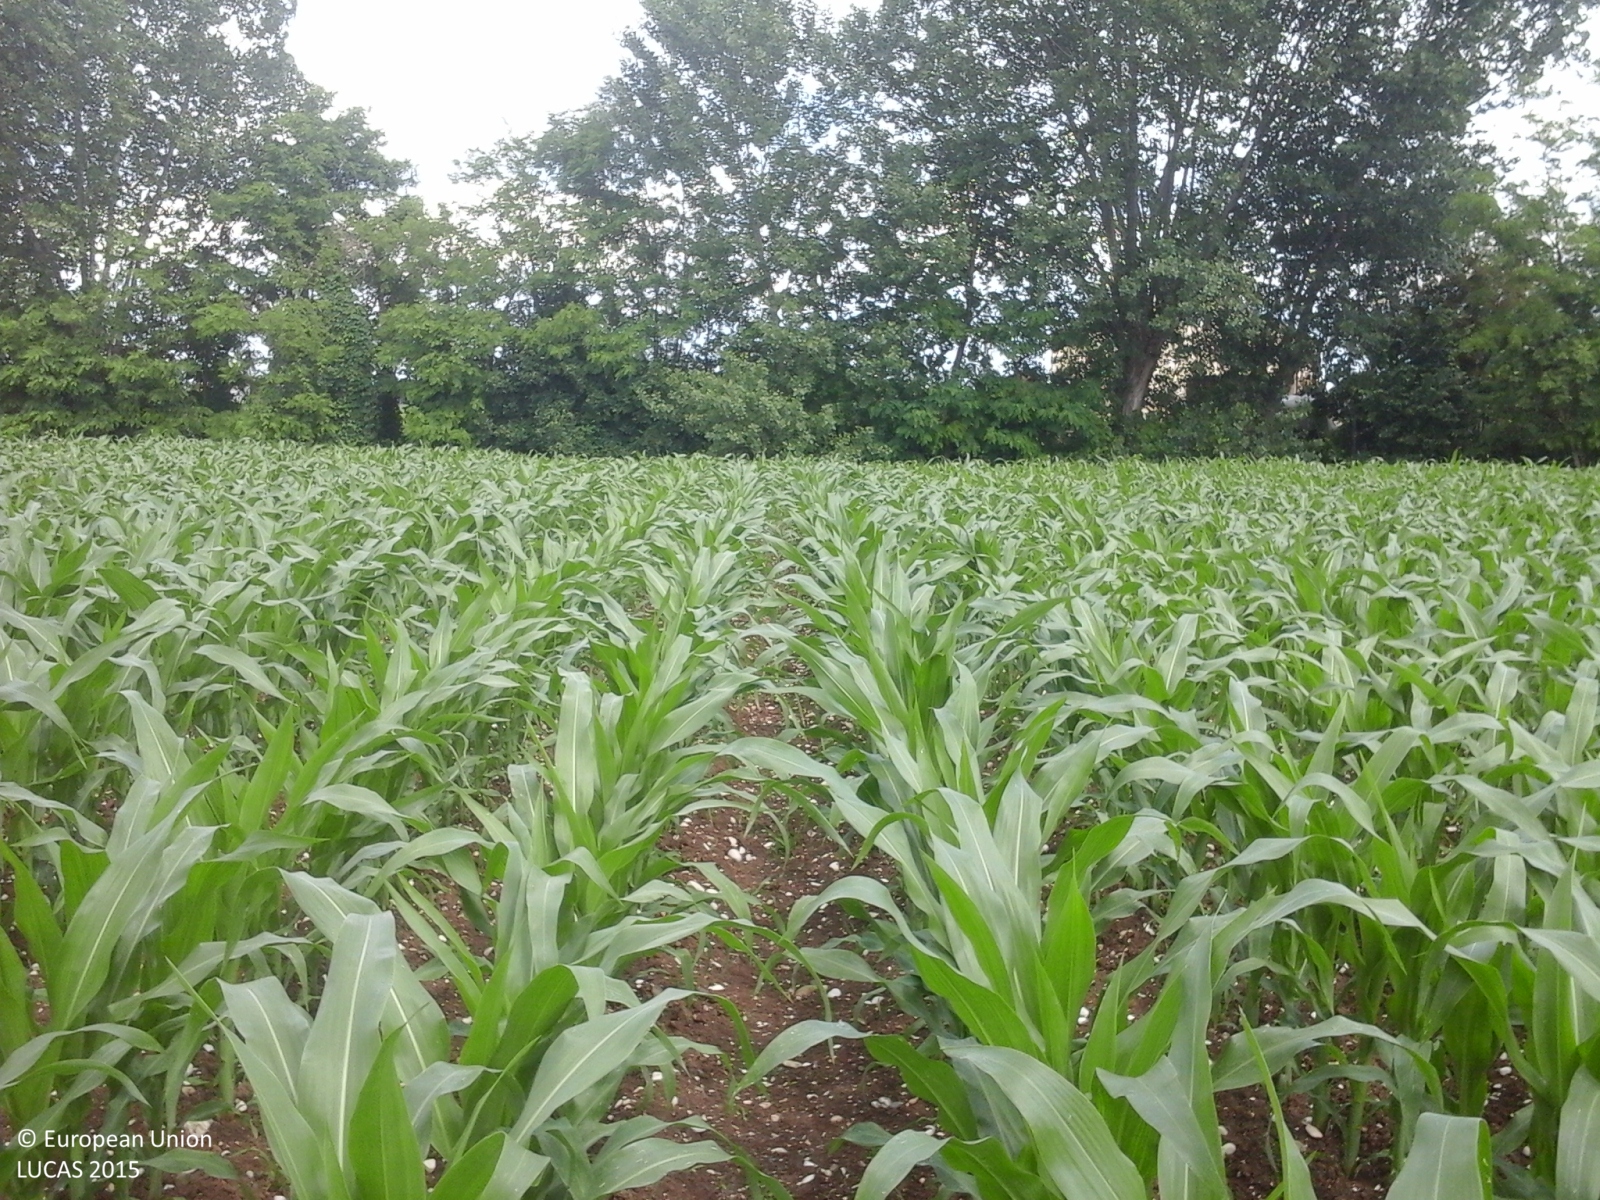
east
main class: Cropland
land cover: Maize
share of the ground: > 75 %
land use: Agriculture (excluding fallow land and kitchen gardens)
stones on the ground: 10 - 25 %
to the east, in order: Maize; Grass margins; Tracks; Grassland without tree/shrub cover; Inland fresh running water; Abandoned hedges; Grassland without tree/shrub cover; Artificial constructions in urban areas; Grassland without tree/shrub cover; Electric lines; Grassland without tree/shrub cover; Paved roads, cycling and walking lanes; Grassland without tree/shrub cover; Electric lines; Grassland without tree/shrub cover
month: May
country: IT
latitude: 45.6901
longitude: 11.6283
